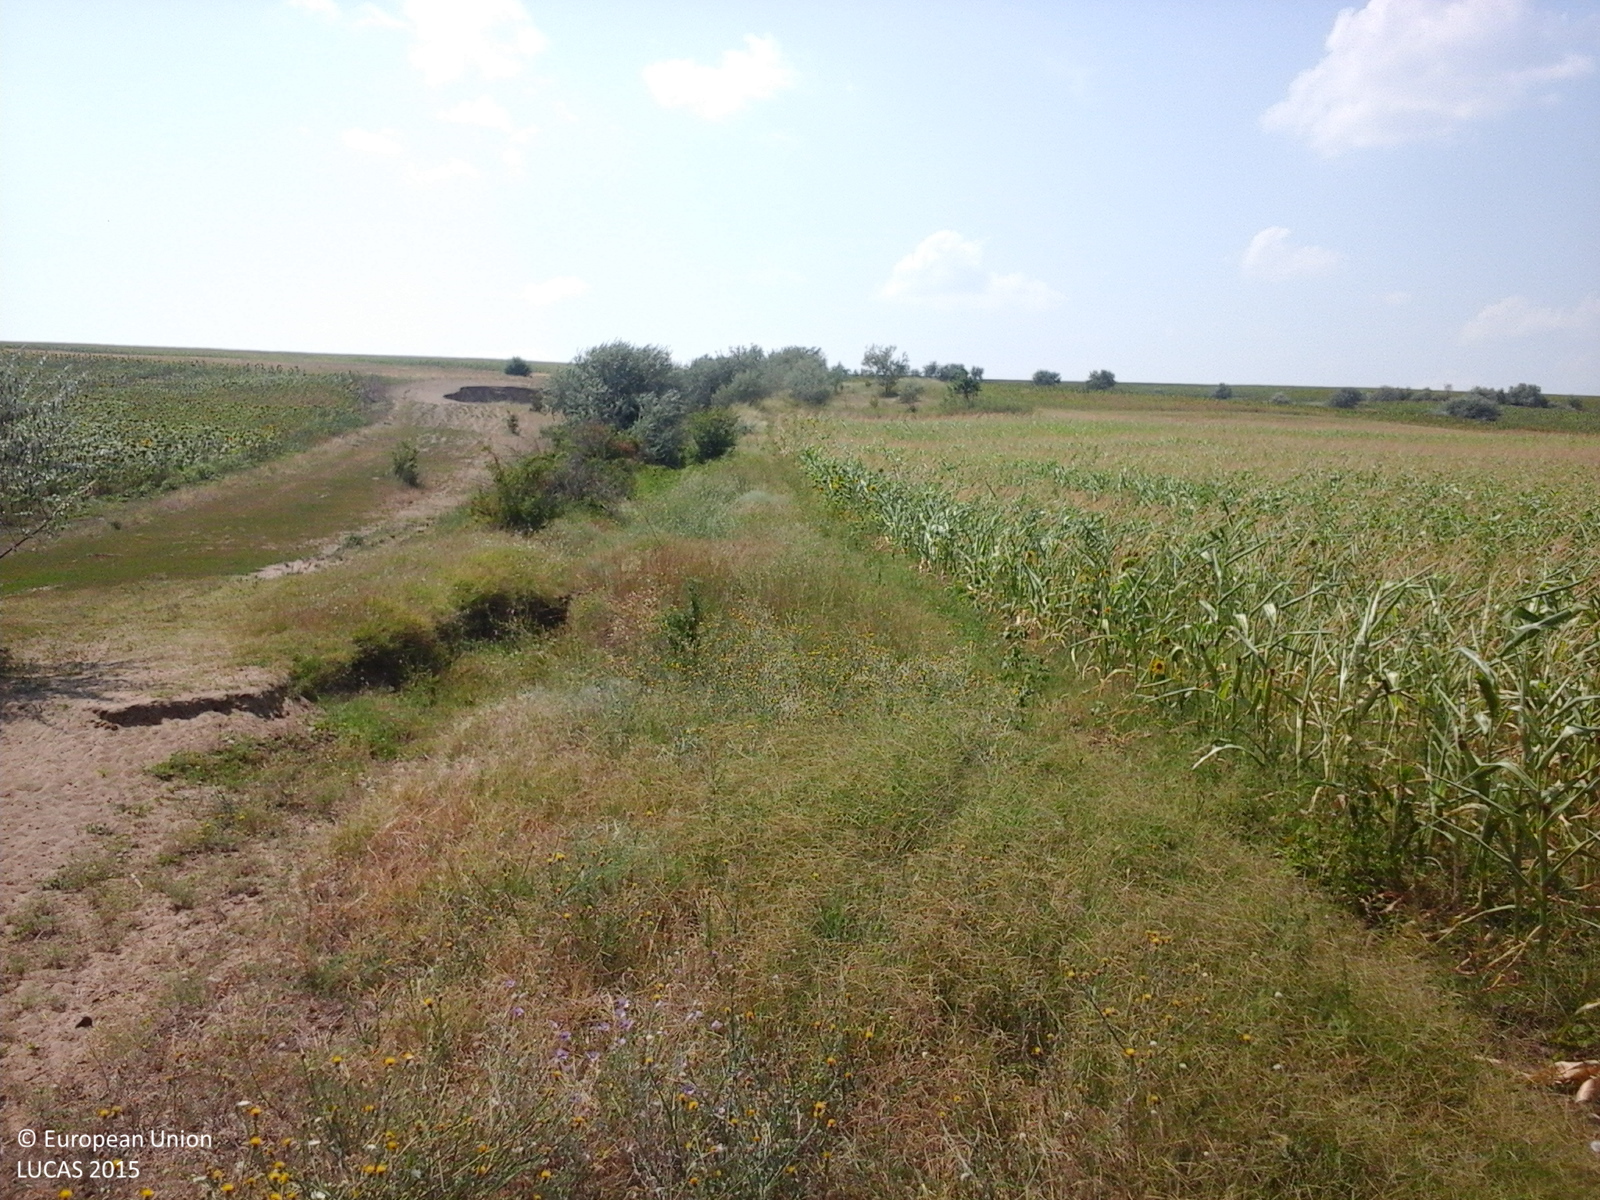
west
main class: Grassland
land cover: Spontaneously vegetated surfaces
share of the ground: > 75 %
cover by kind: herbaceous plants 100 %
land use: Semi-natural and natural areas not in use
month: July
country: RO
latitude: 45.9178
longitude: 27.9781
